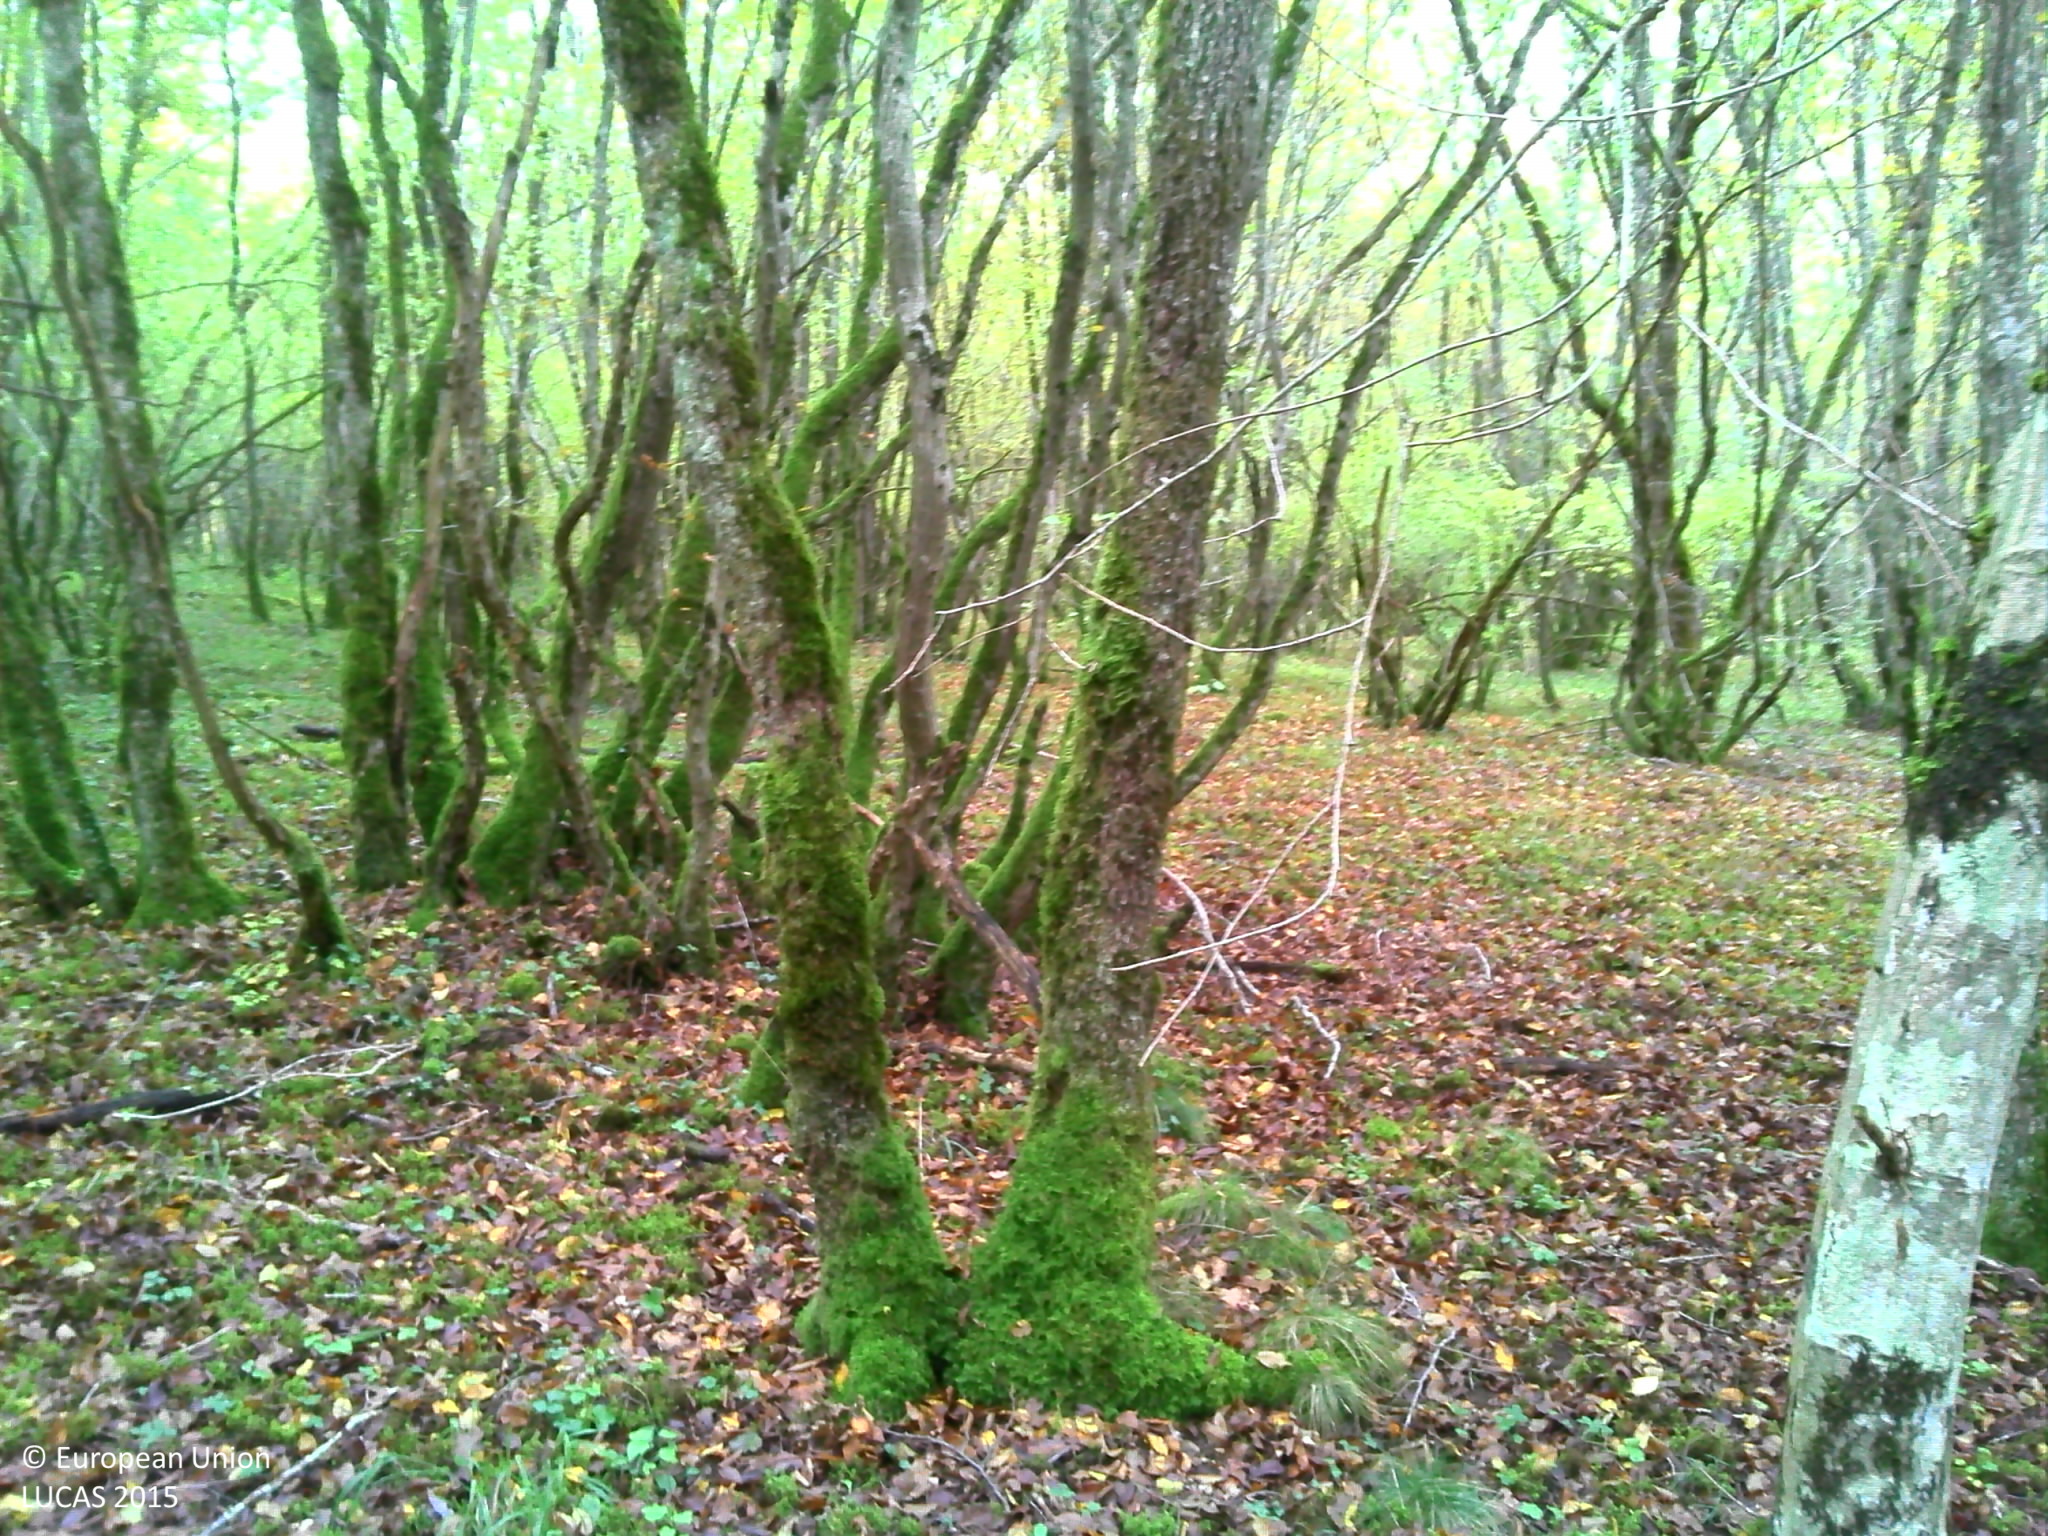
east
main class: Woodland
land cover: Broadleaved woodland
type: mesophytic deciduous forest
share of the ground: > 75 %
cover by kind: broadleaved forest trees 90 %, herbaceous plants 10 %
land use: Forestry
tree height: > 5 m
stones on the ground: < 10 %
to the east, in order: Broadleaved woodland; Tracks; Broadleaved woodland; Tracks; Broadleaved woodland
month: October
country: FR
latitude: 47.5328
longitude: 4.9921
